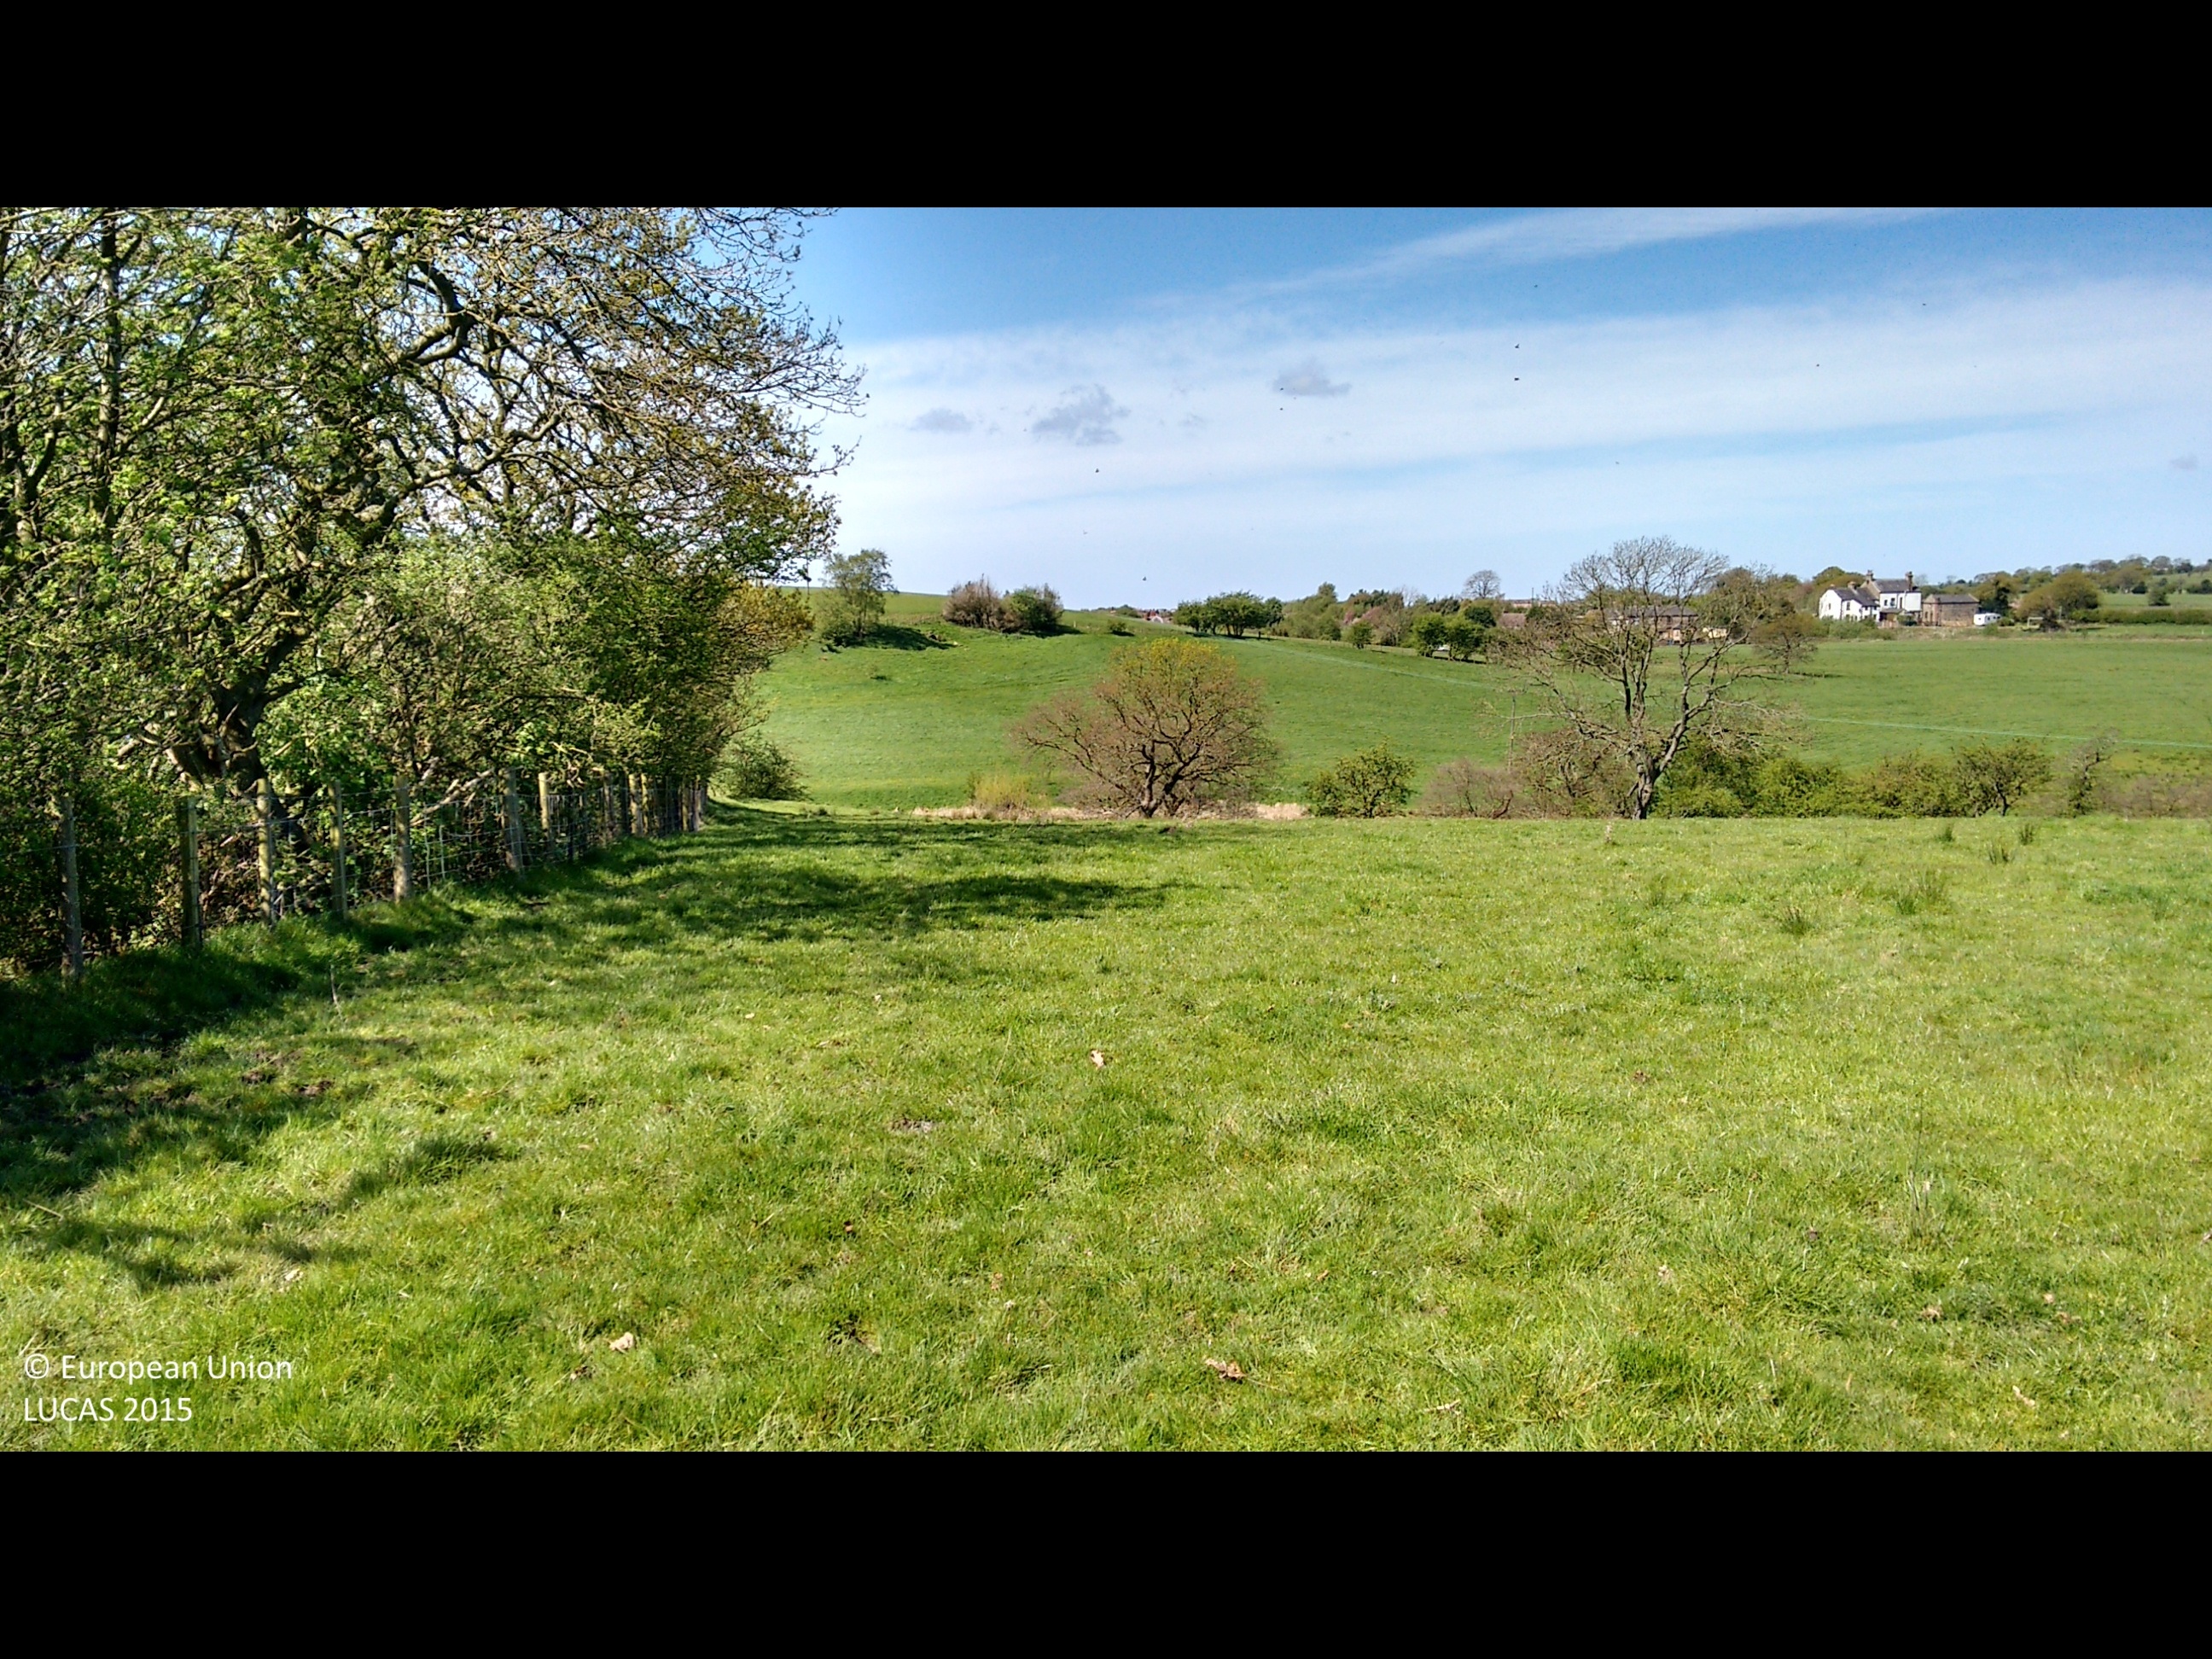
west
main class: Grassland
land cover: Grassland without tree/shrub cover
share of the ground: > 75 %
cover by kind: herbaceous plants 100 %
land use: Agriculture (excluding fallow land and kitchen gardens)
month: May
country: GB
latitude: 53.6707
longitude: -2.5844
